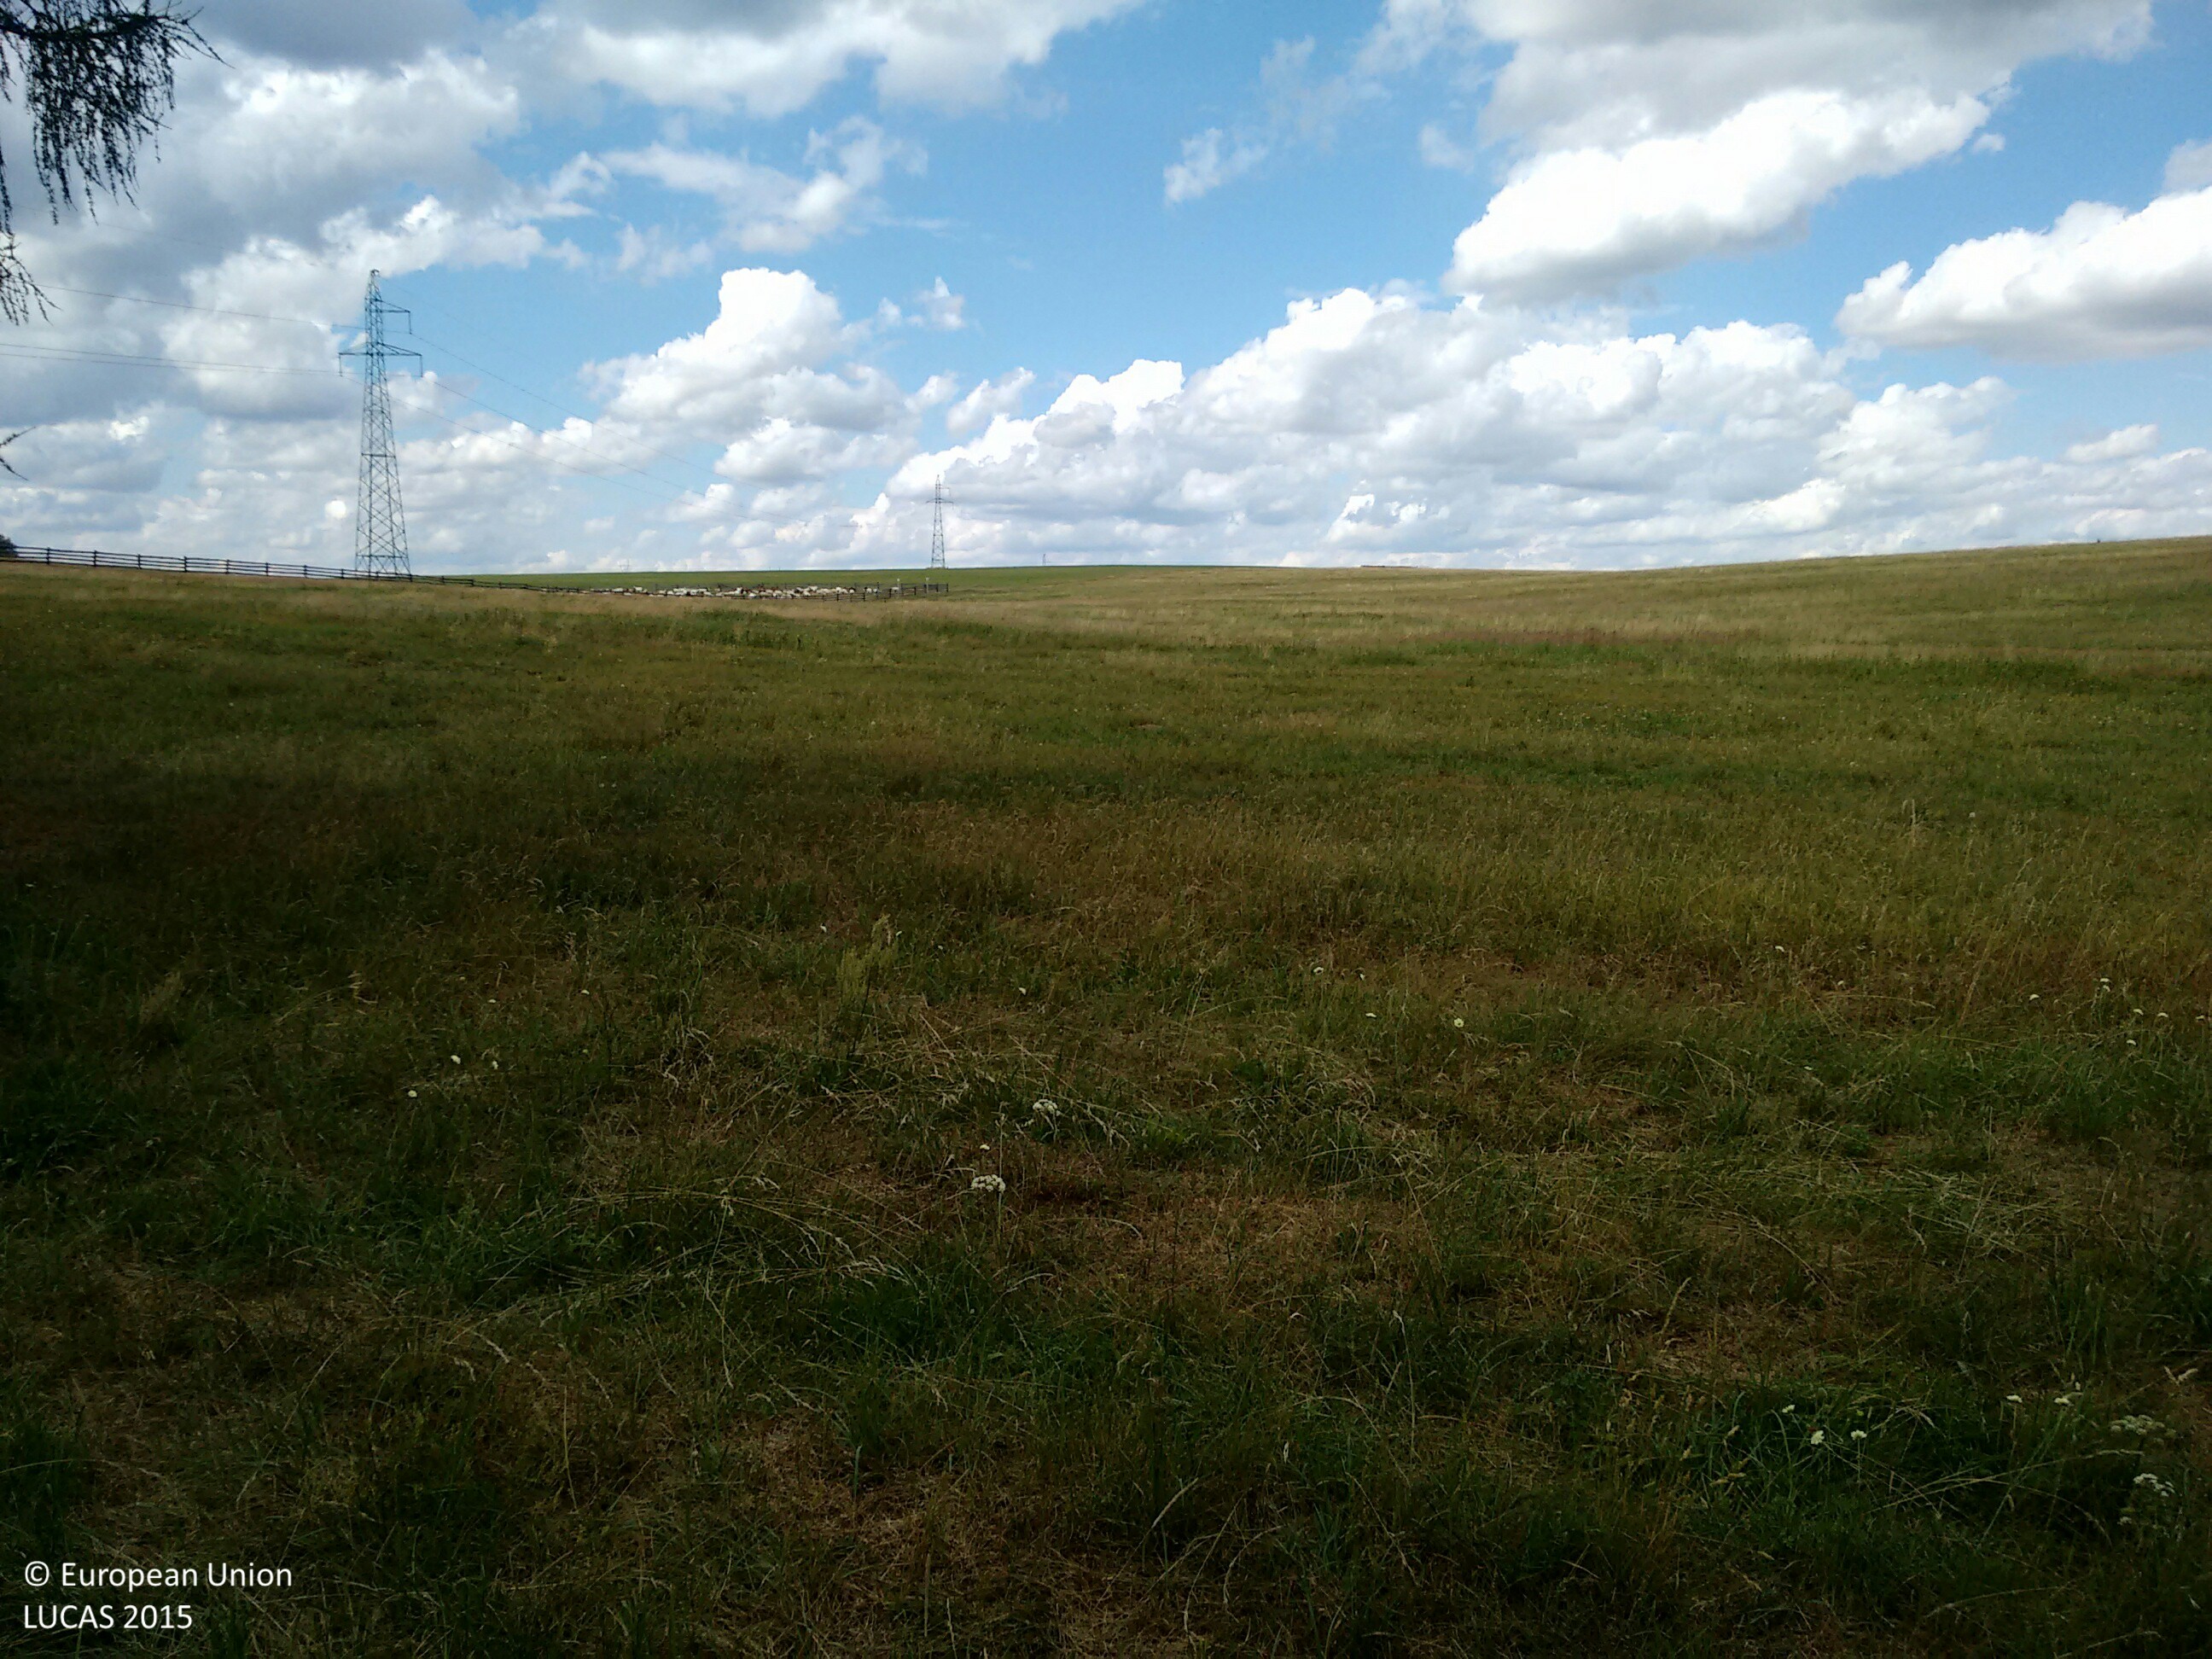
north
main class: Grassland
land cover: Grassland with sparse tree/shrub cover
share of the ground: > 75 %
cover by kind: herbaceous plants 95 %, coniferous forest trees 5 %
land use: Forestry
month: July
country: PL
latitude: 50.5498
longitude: 19.4691
